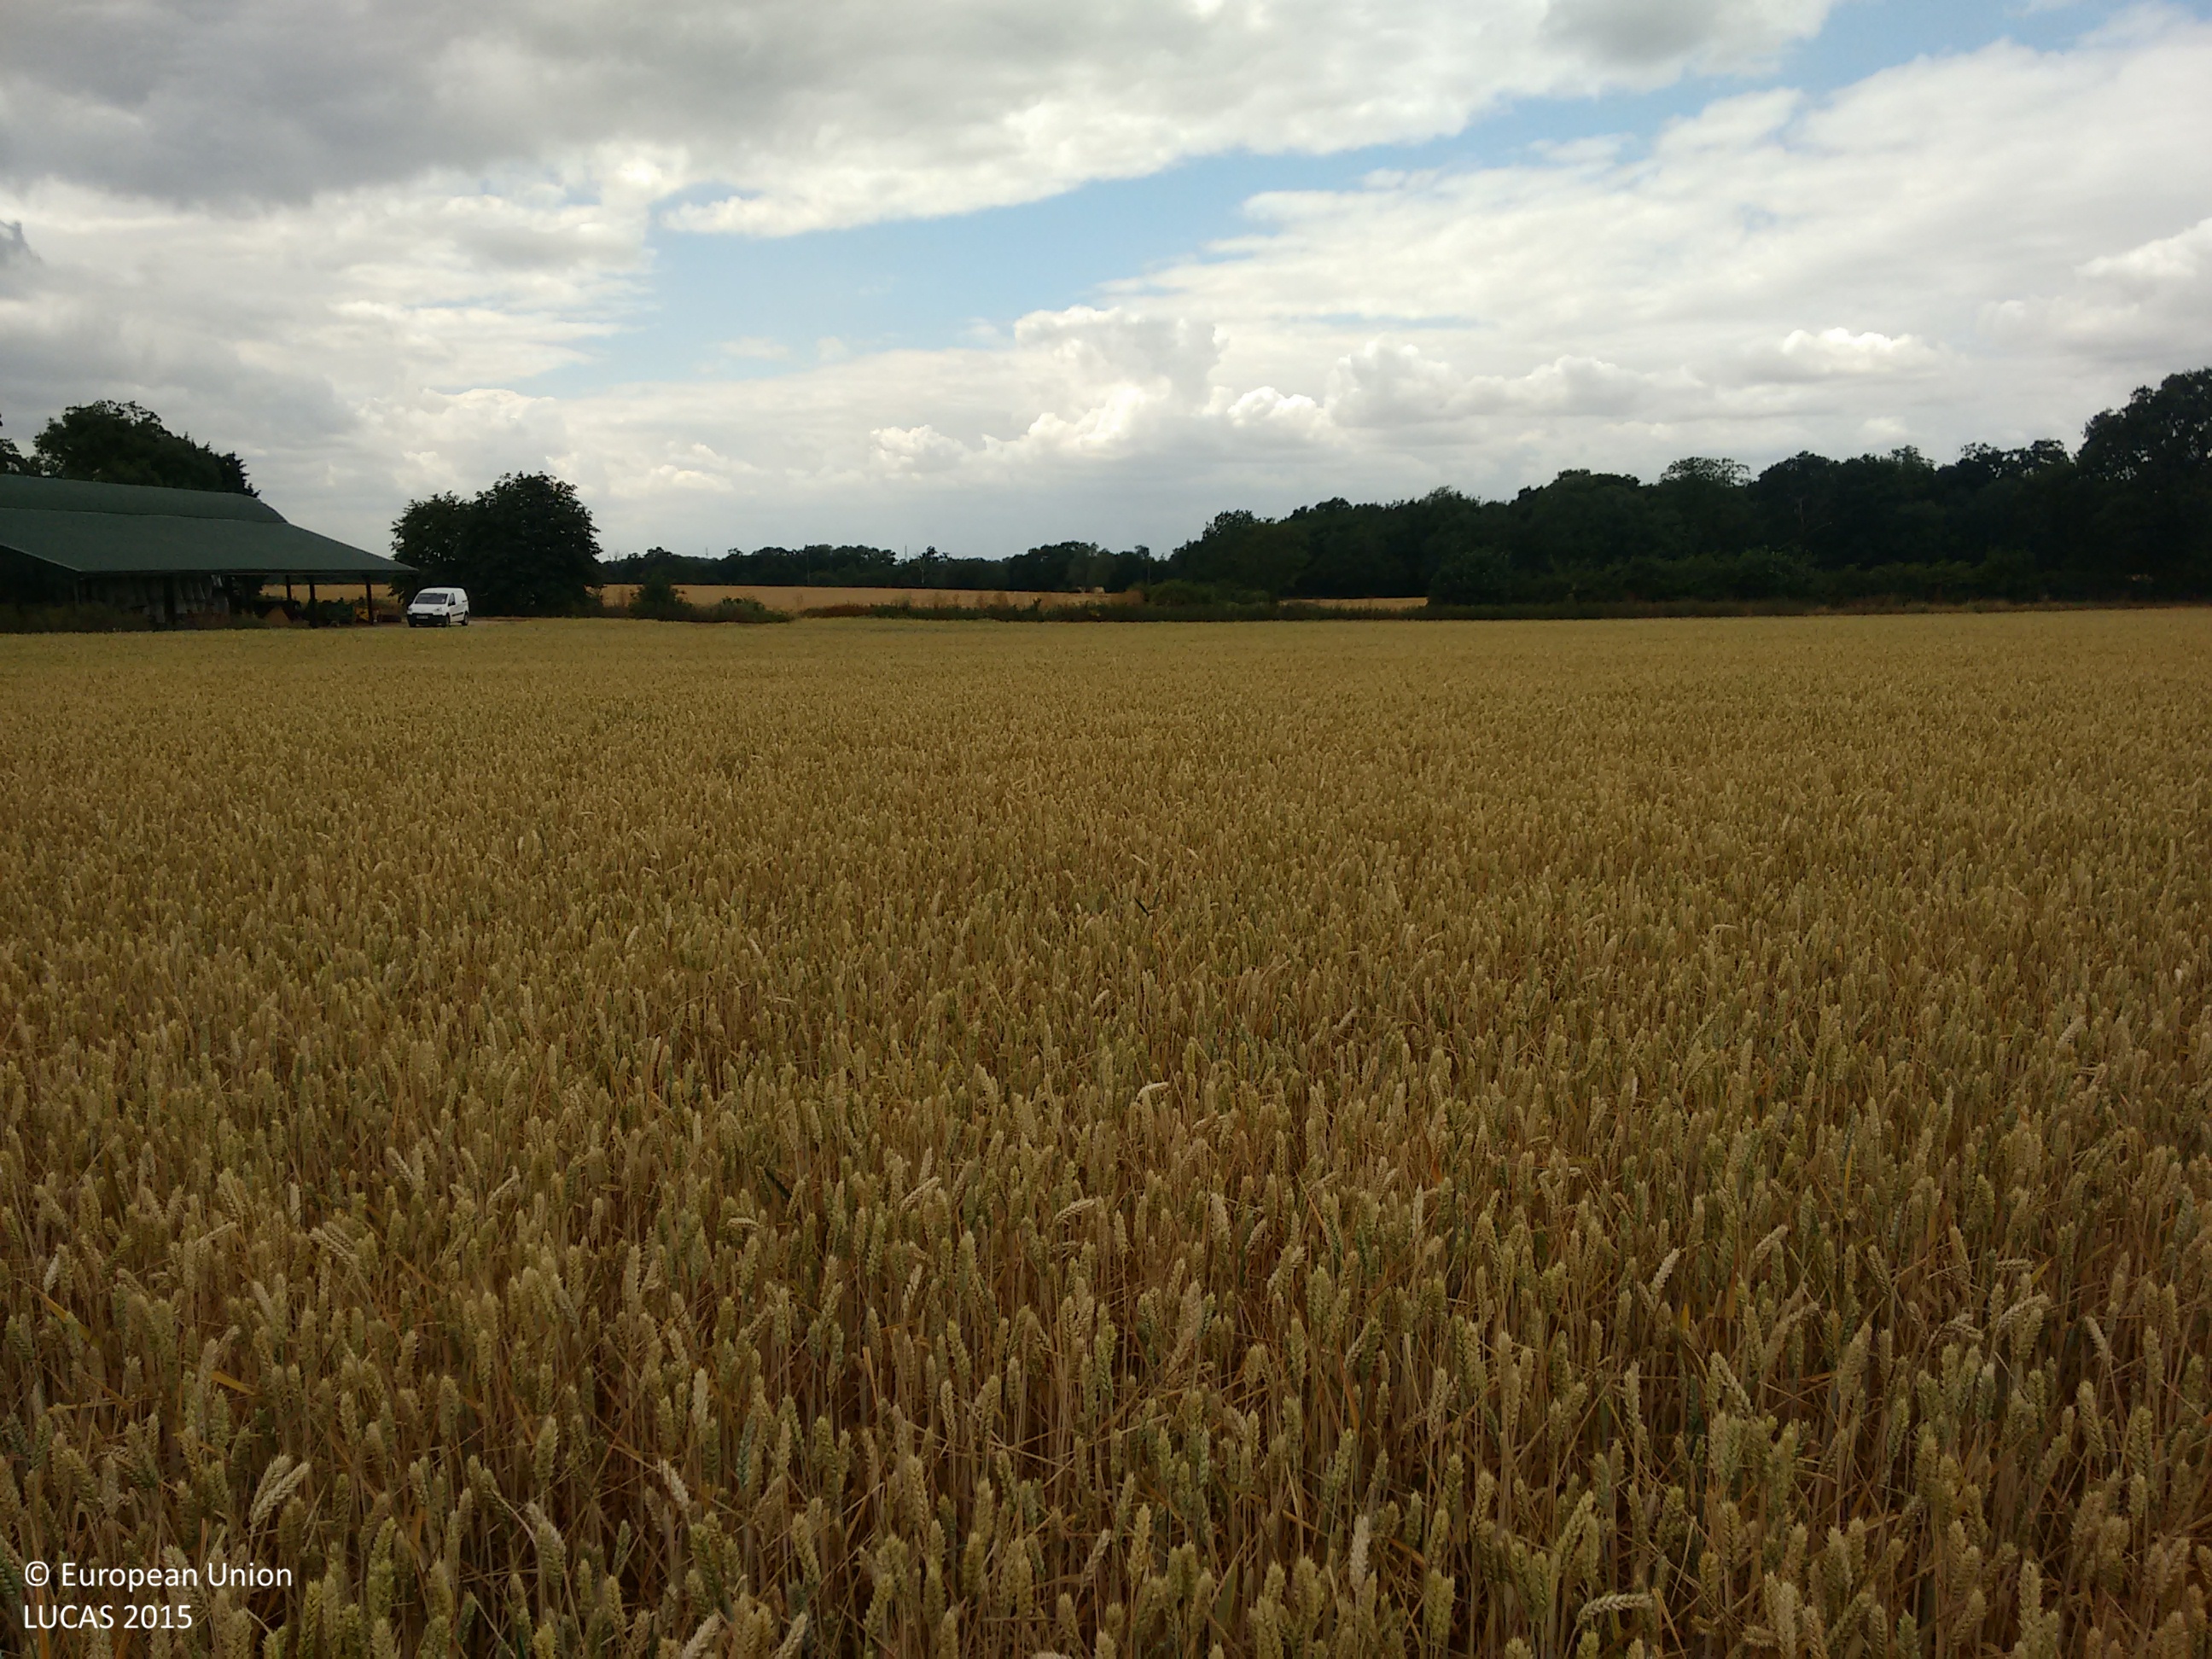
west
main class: Cropland
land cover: Common wheat
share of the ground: > 75 %
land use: Agriculture (excluding fallow land and kitchen gardens)
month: July
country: GB
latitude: 51.8038
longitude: 0.5900
